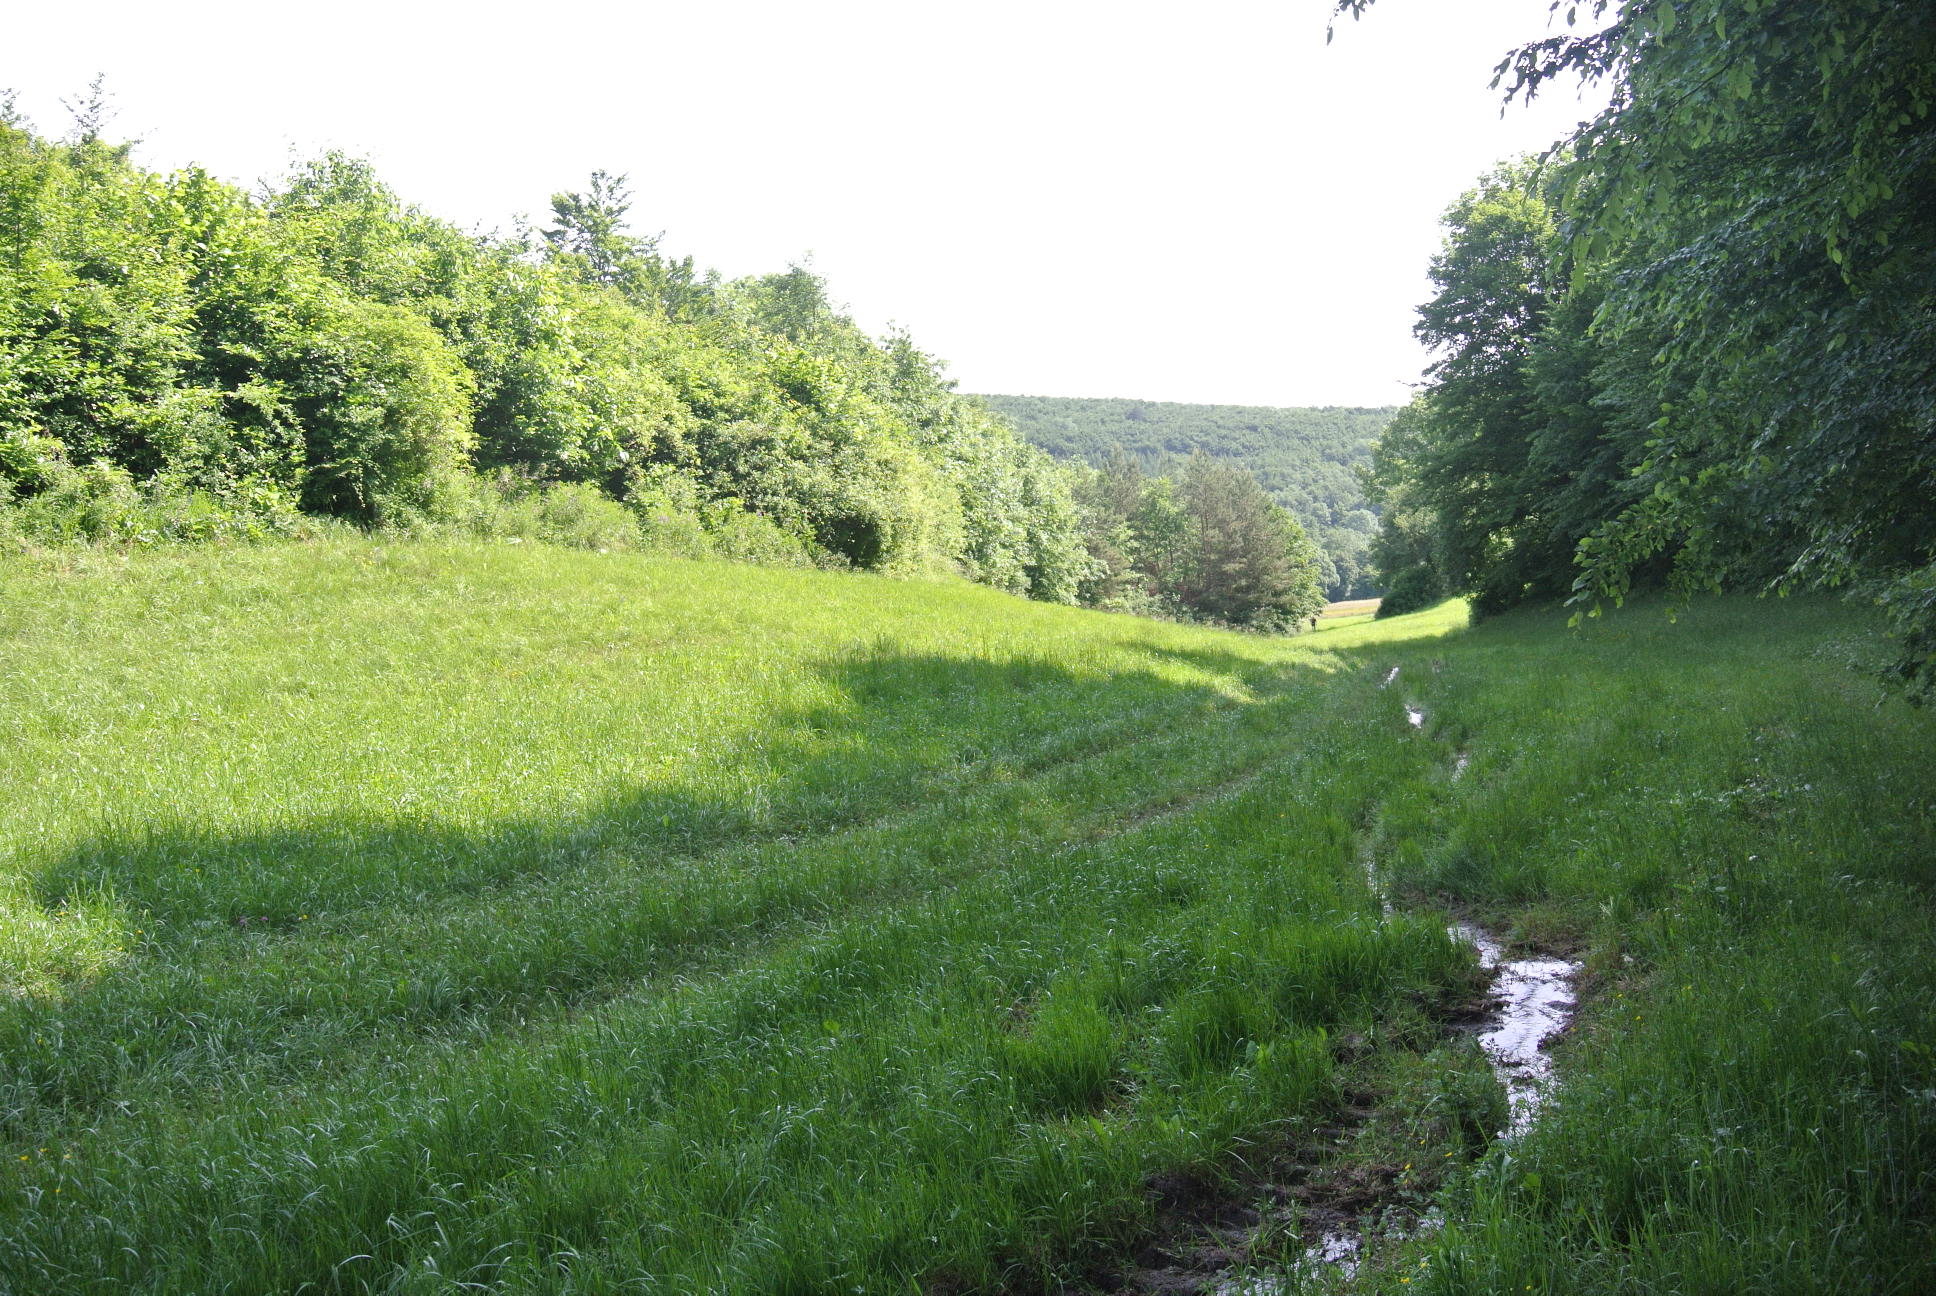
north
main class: Grassland
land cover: Grassland without tree/shrub cover
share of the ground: > 75 %
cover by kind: herbaceous plants 100 %
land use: Agriculture (excluding fallow land and kitchen gardens)
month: June
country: AT
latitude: 48.0571
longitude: 16.0548
